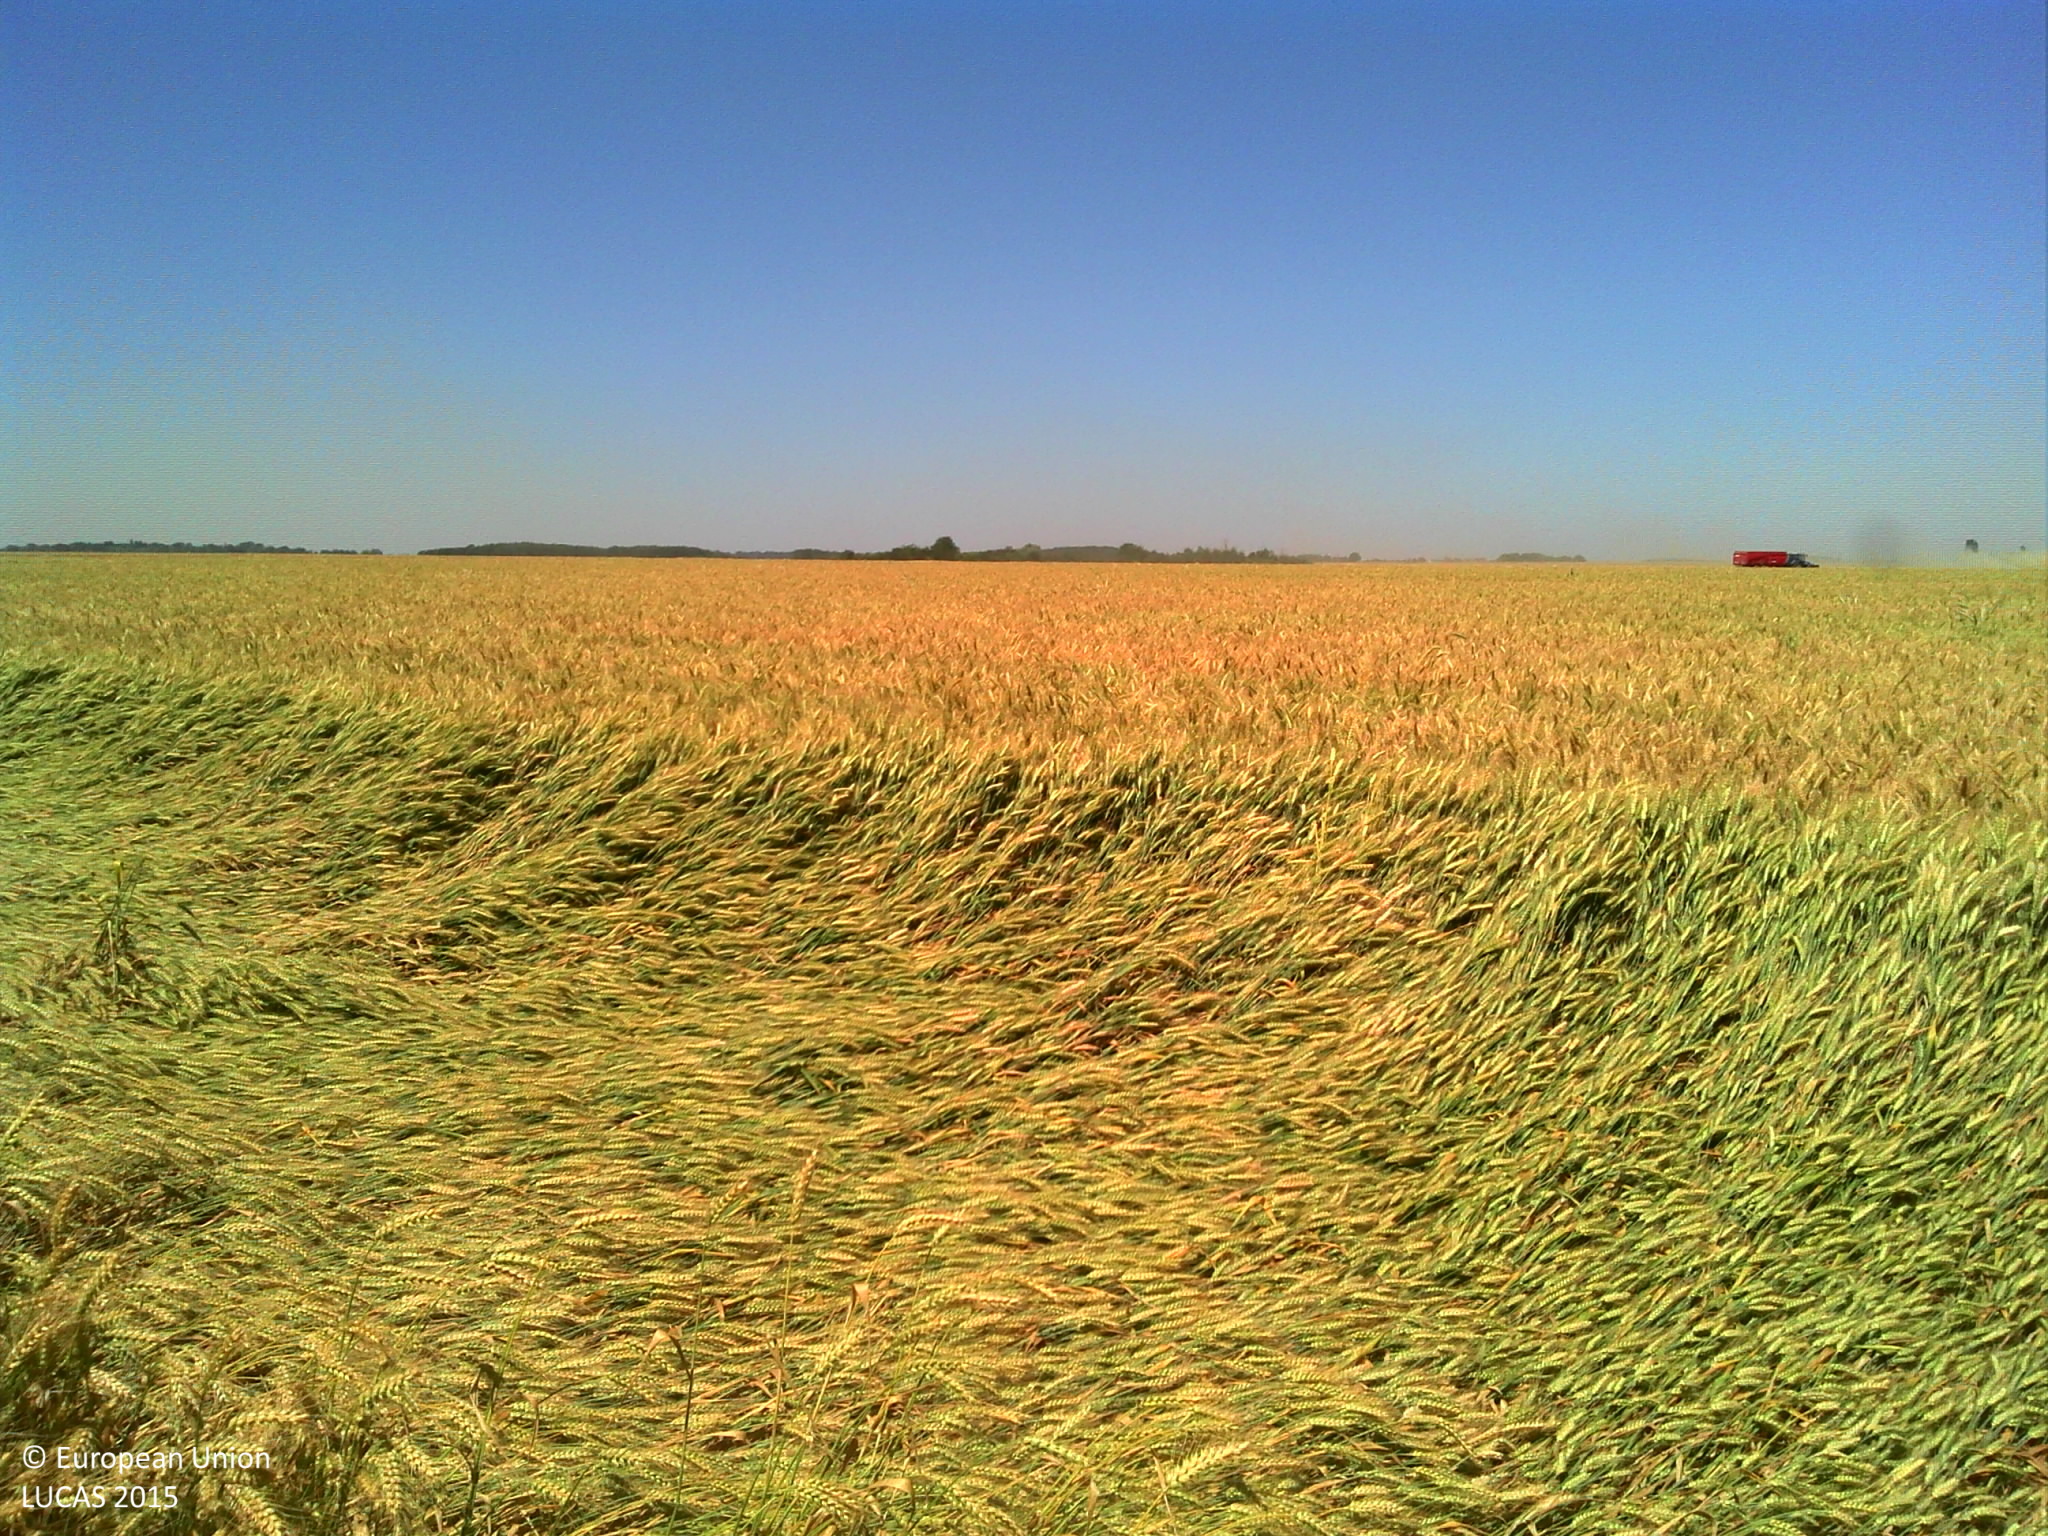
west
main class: Cropland
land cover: Common wheat
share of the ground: > 75 %
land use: Agriculture (excluding fallow land and kitchen gardens)
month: June
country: FR
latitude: 48.6849
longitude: 1.1922
